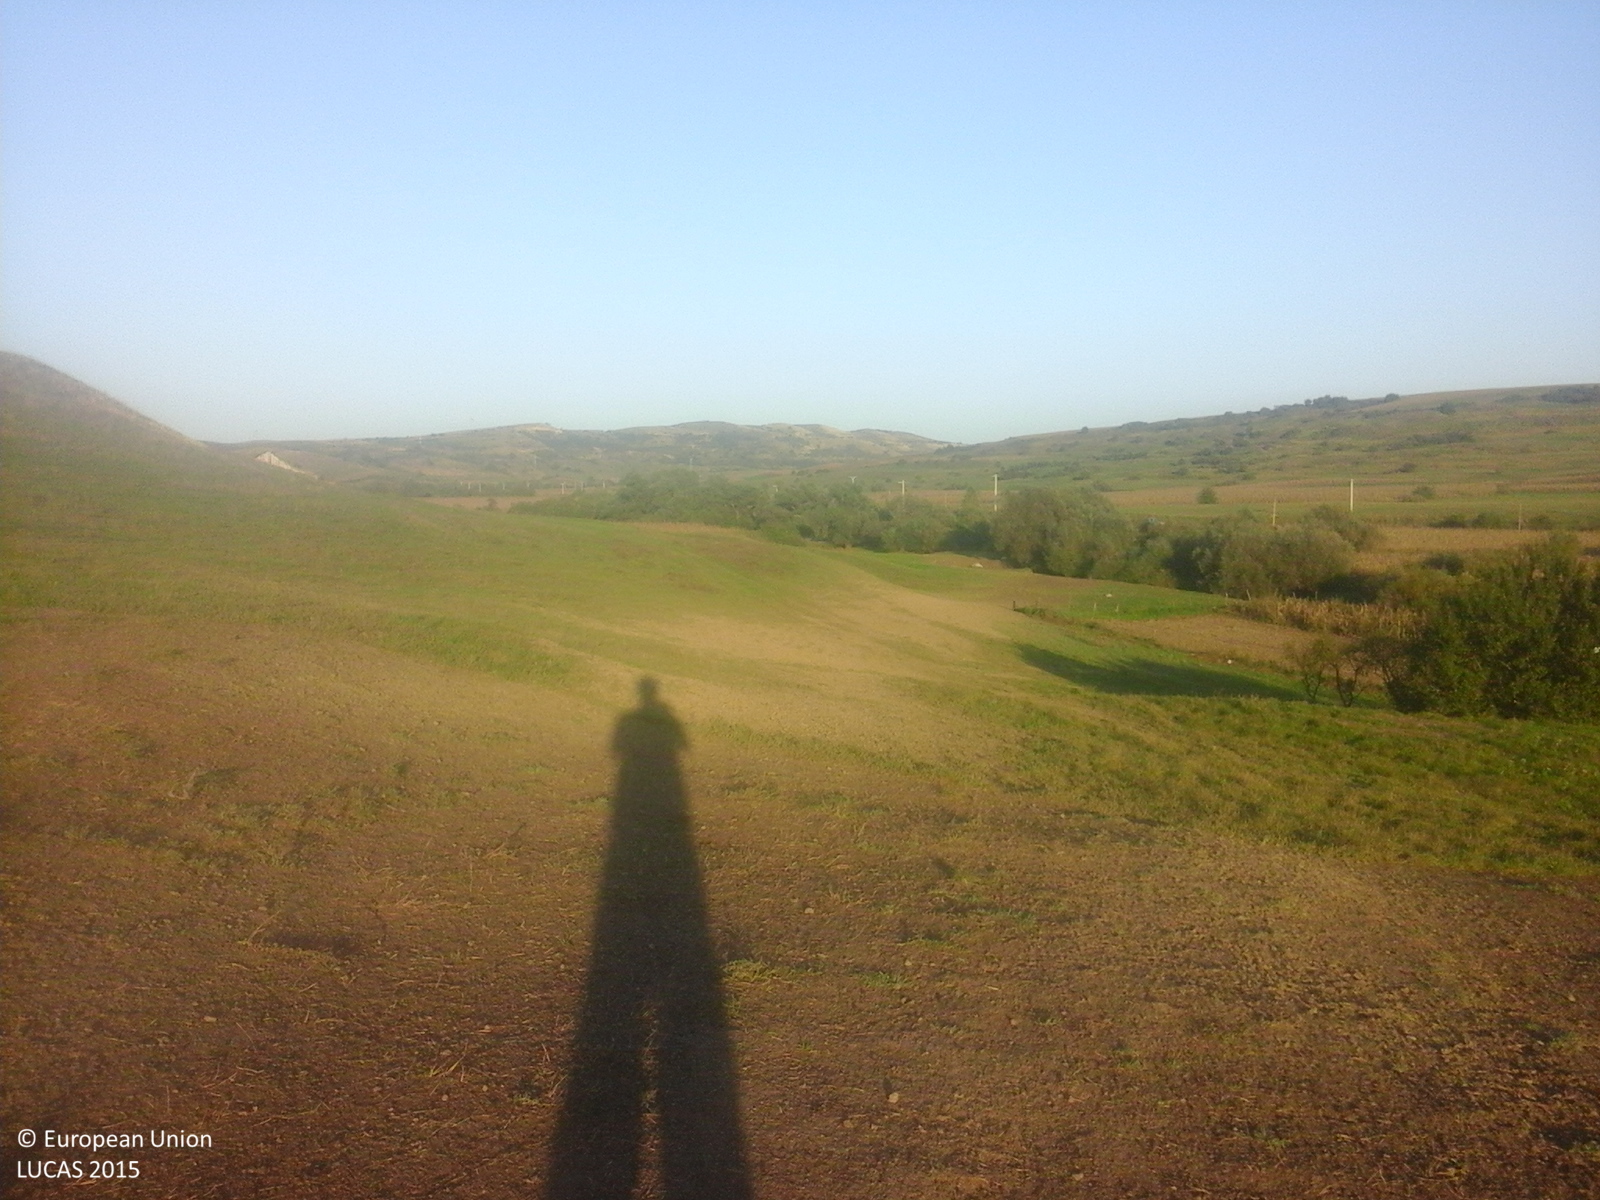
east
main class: Grassland
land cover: Grassland without tree/shrub cover
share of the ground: > 75 %
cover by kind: herbaceous plants 100 %
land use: Agriculture (excluding fallow land and kitchen gardens)
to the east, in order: Grassland without tree/shrub cover; Abandoned hedges
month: October
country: RO
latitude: 45.9243
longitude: 24.0914
